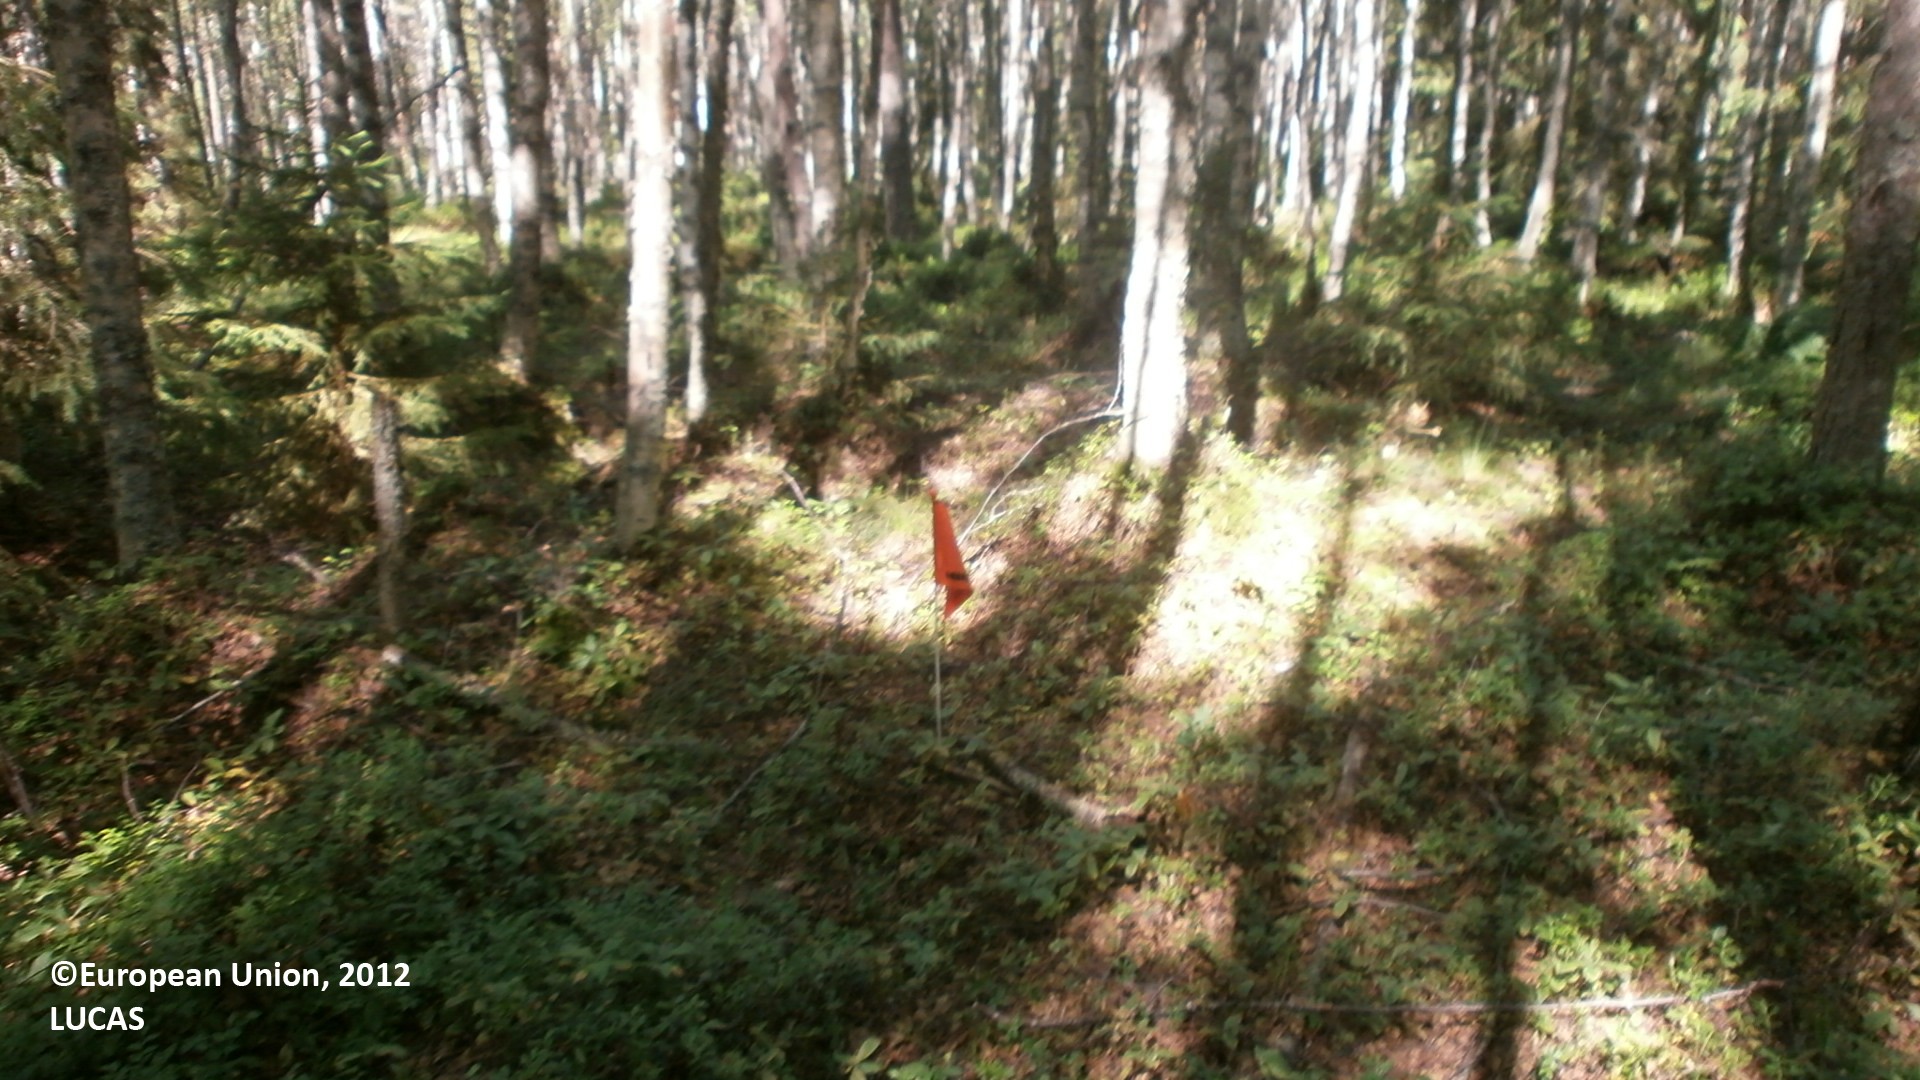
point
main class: Woodland
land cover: Broadleaved woodland
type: boreal forest
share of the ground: > 75 %
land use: Forestry
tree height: > 5 m
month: July
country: FI
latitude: 64.2810
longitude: 24.0877
